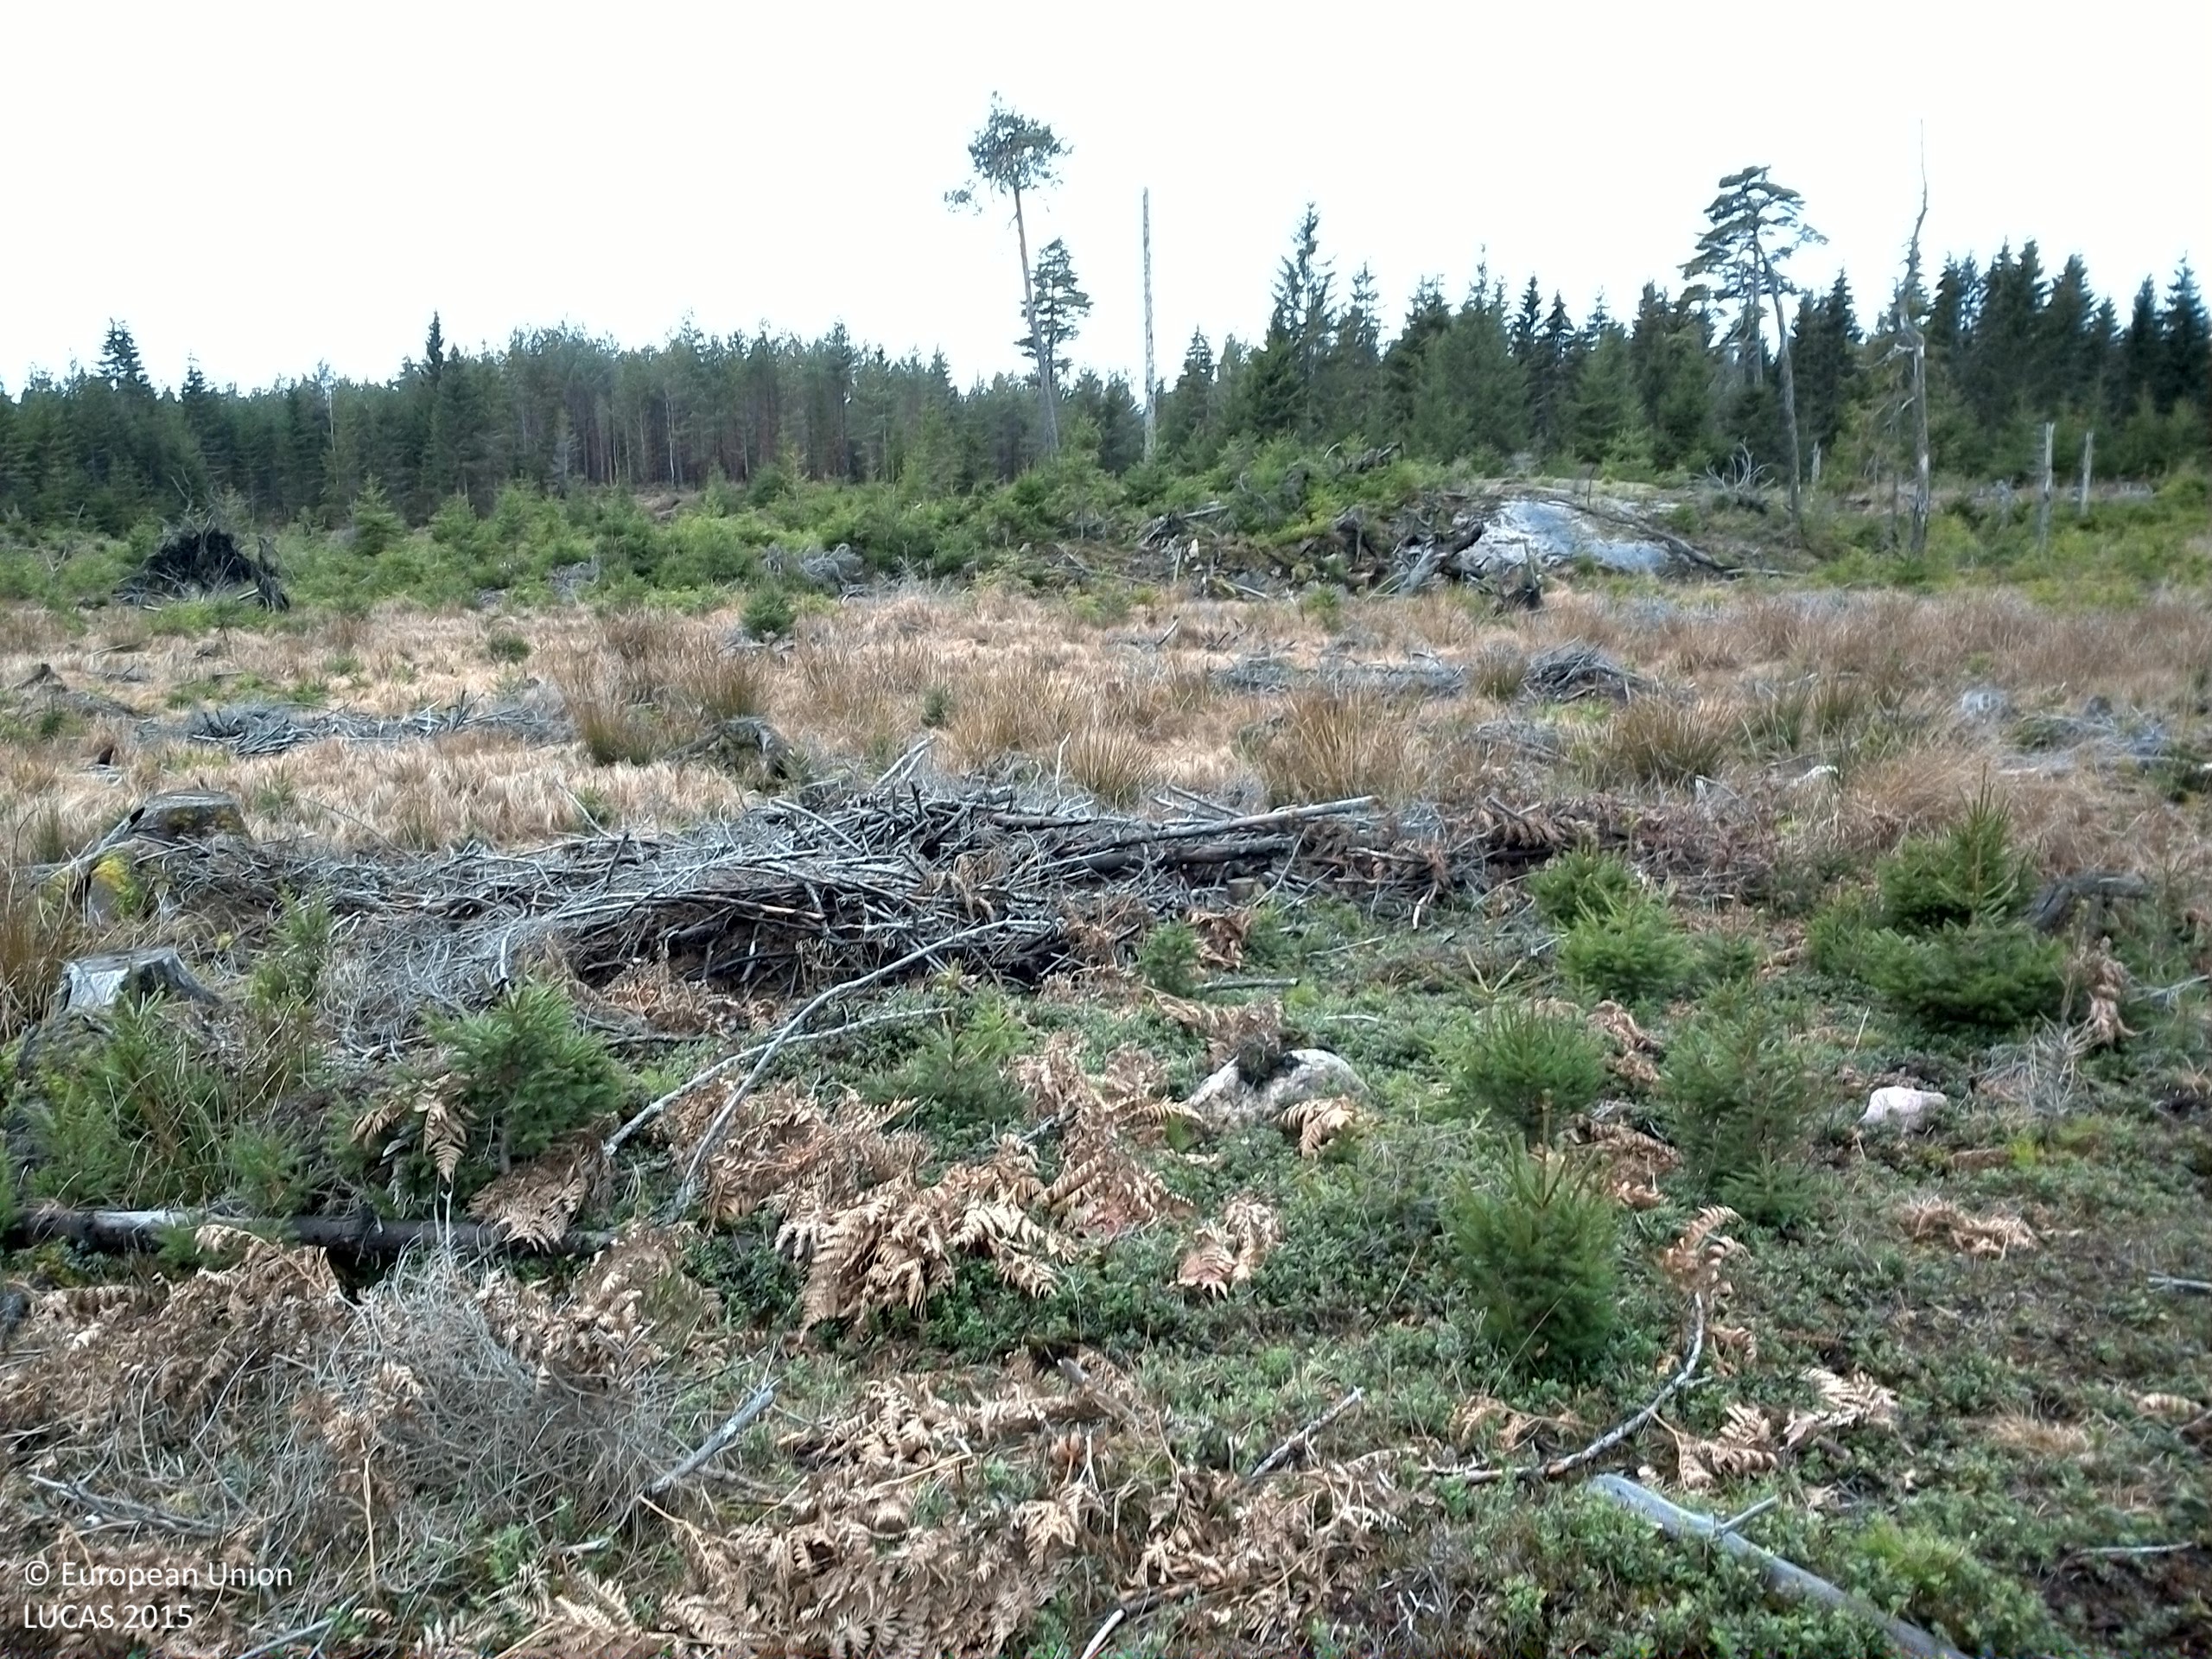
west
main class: Woodland
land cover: Spruce dominated coniferous woodland
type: boreal forest
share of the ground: 10 - 25 %
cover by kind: herbaceous plants 50 %, coniferous forest trees 20 %, shrubs 10 %, lichens and mosses 10 %, unconsolidated bare surface 10 %
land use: Forestry
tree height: < 5 m
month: November
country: SE
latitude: 58.9261
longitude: 16.9265
